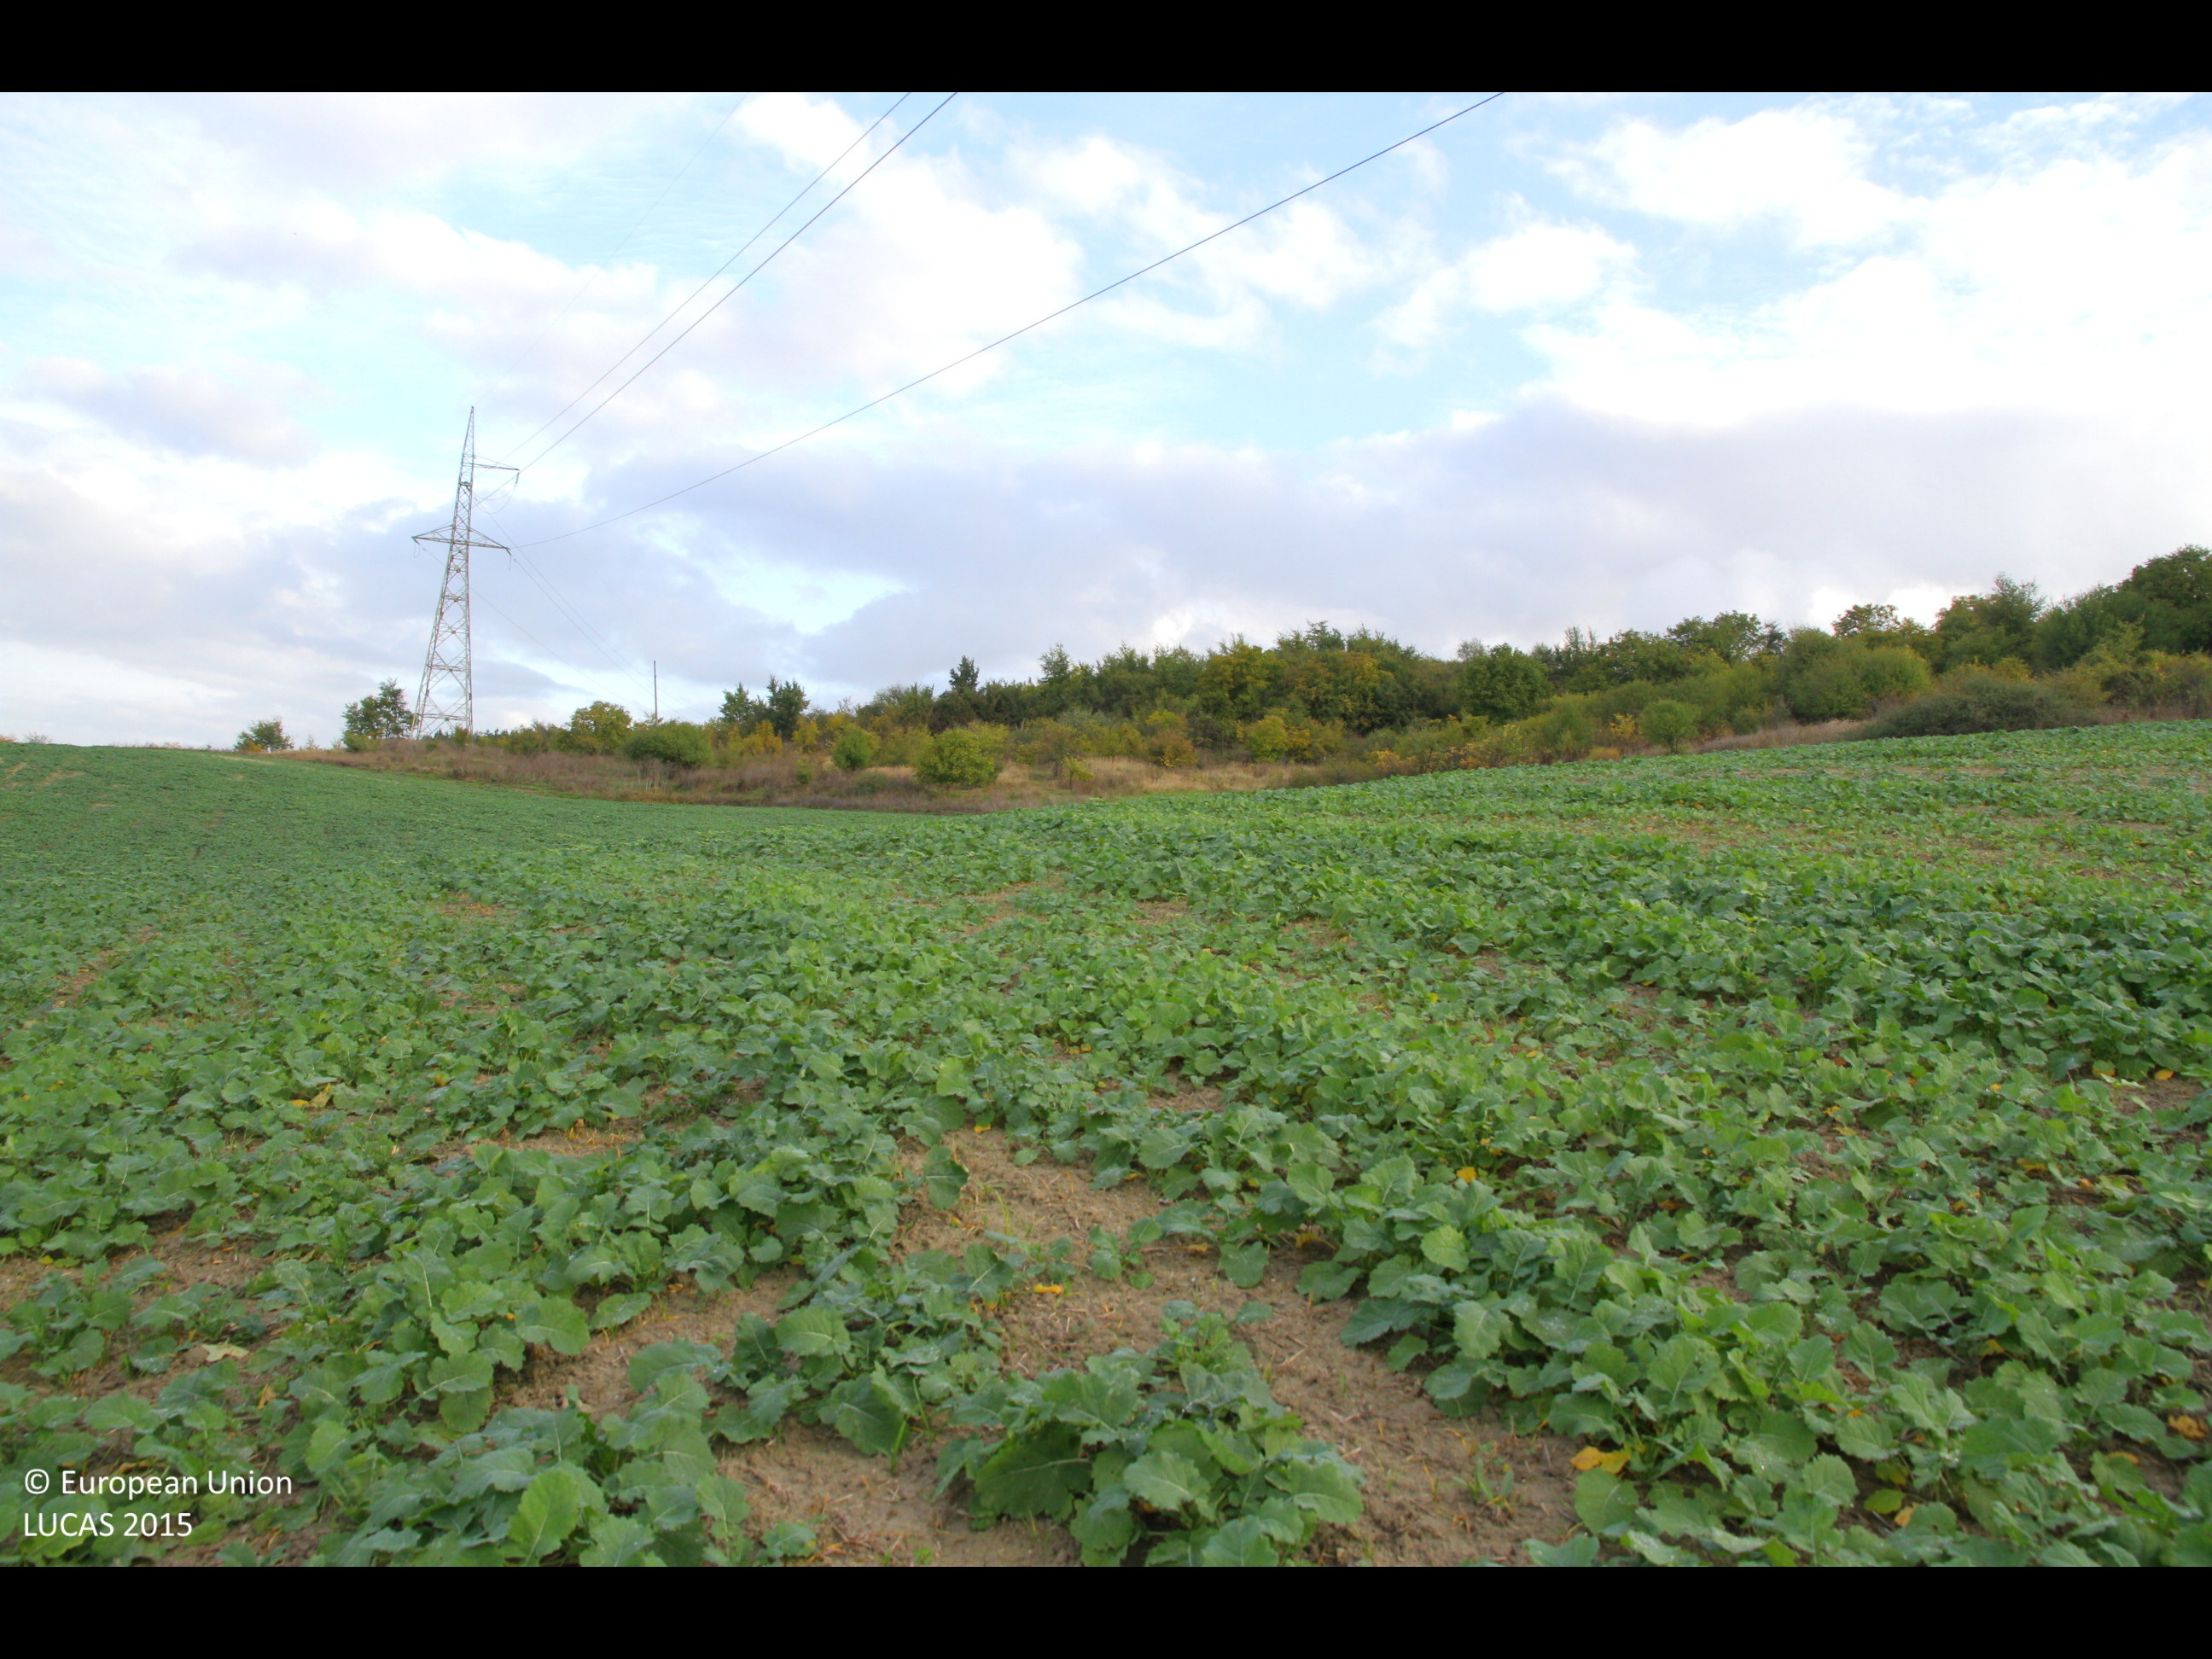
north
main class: Cropland
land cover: Rape and turnip rape
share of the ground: > 75 %
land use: Agriculture (excluding fallow land and kitchen gardens)
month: October
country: BG
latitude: 43.2265
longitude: 27.0190
